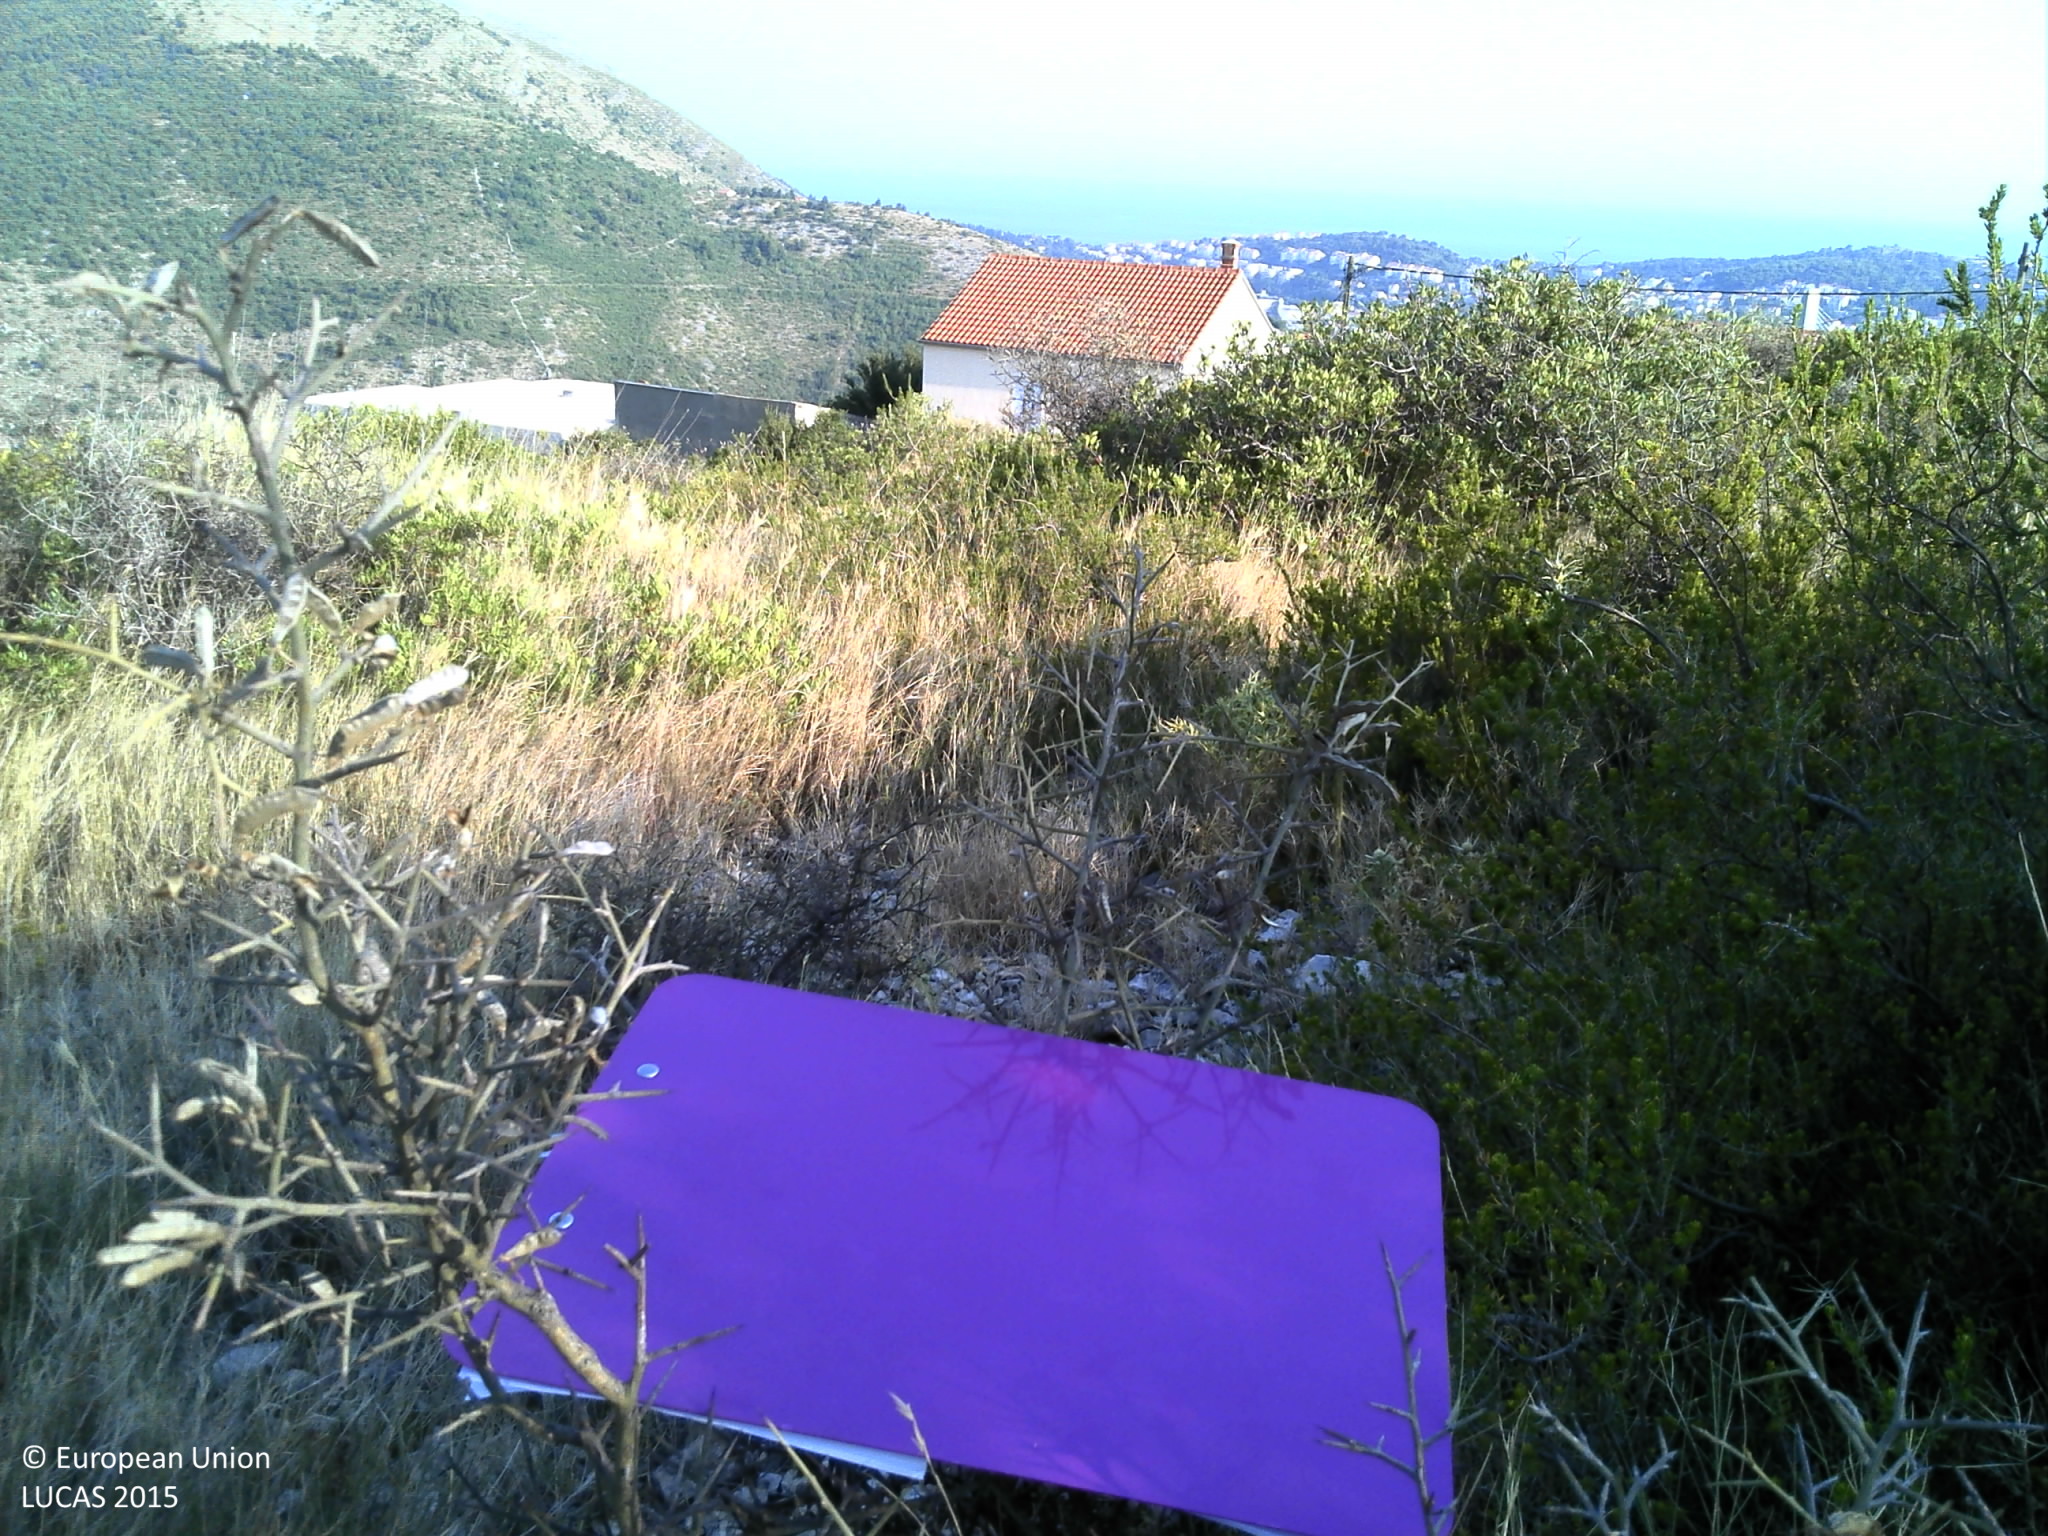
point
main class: Shrubland
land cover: Shrubland without tree cover
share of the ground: 50 - 75 %
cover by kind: shrubs 50 %, herbaceous plants 25 %, unconsolidated bare surface 15 %, consolidated bare surface 10 %
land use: Semi-natural and natural areas not in use
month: July
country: HR
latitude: 42.6754
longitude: 18.0807
